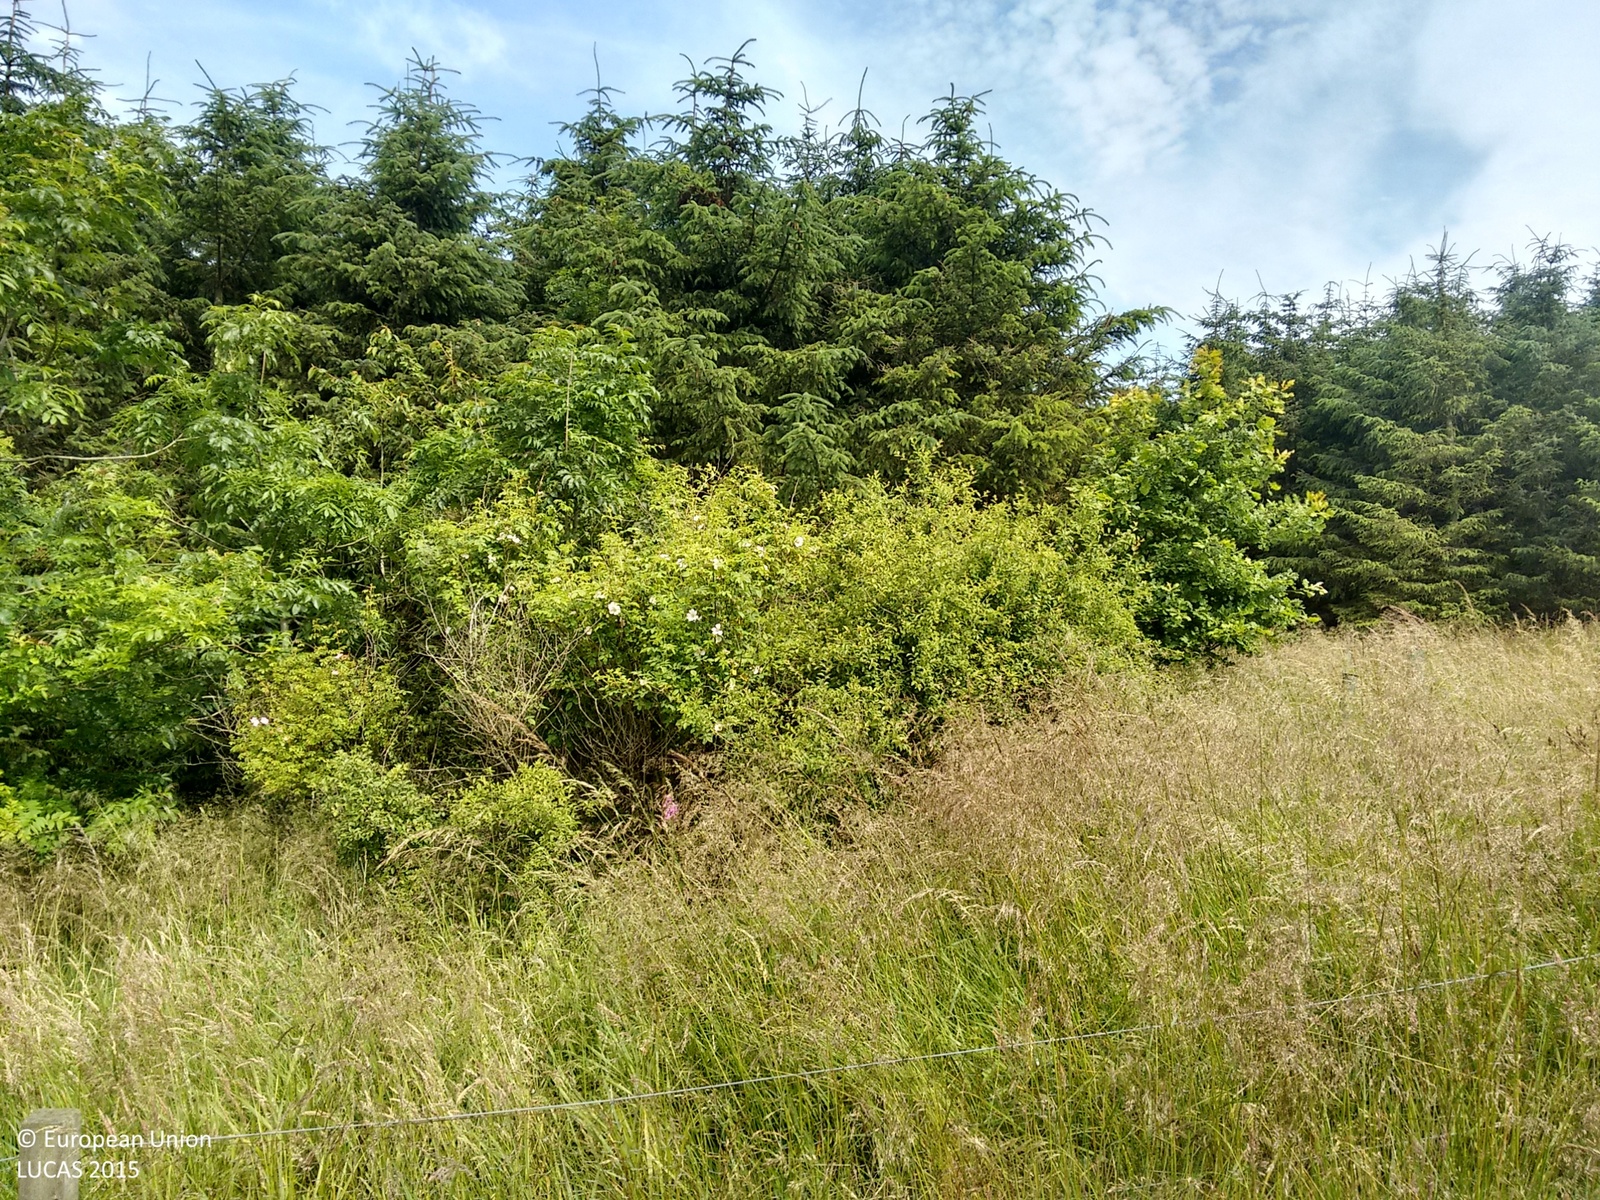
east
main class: Grassland
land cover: Grassland with sparse tree/shrub cover
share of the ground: > 75 %
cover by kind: herbaceous plants 90 %, broadleaved forest trees 5 %, shrubs 5 %
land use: Agriculture (excluding fallow land and kitchen gardens)
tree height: < 5 m
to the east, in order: Grassland with sparse tree/shrub cover; Fences; Grassland with sparse tree/shrub cover; Spruce dominated coniferous woodland
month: July
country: GB
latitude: 56.0935
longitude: -3.3016
